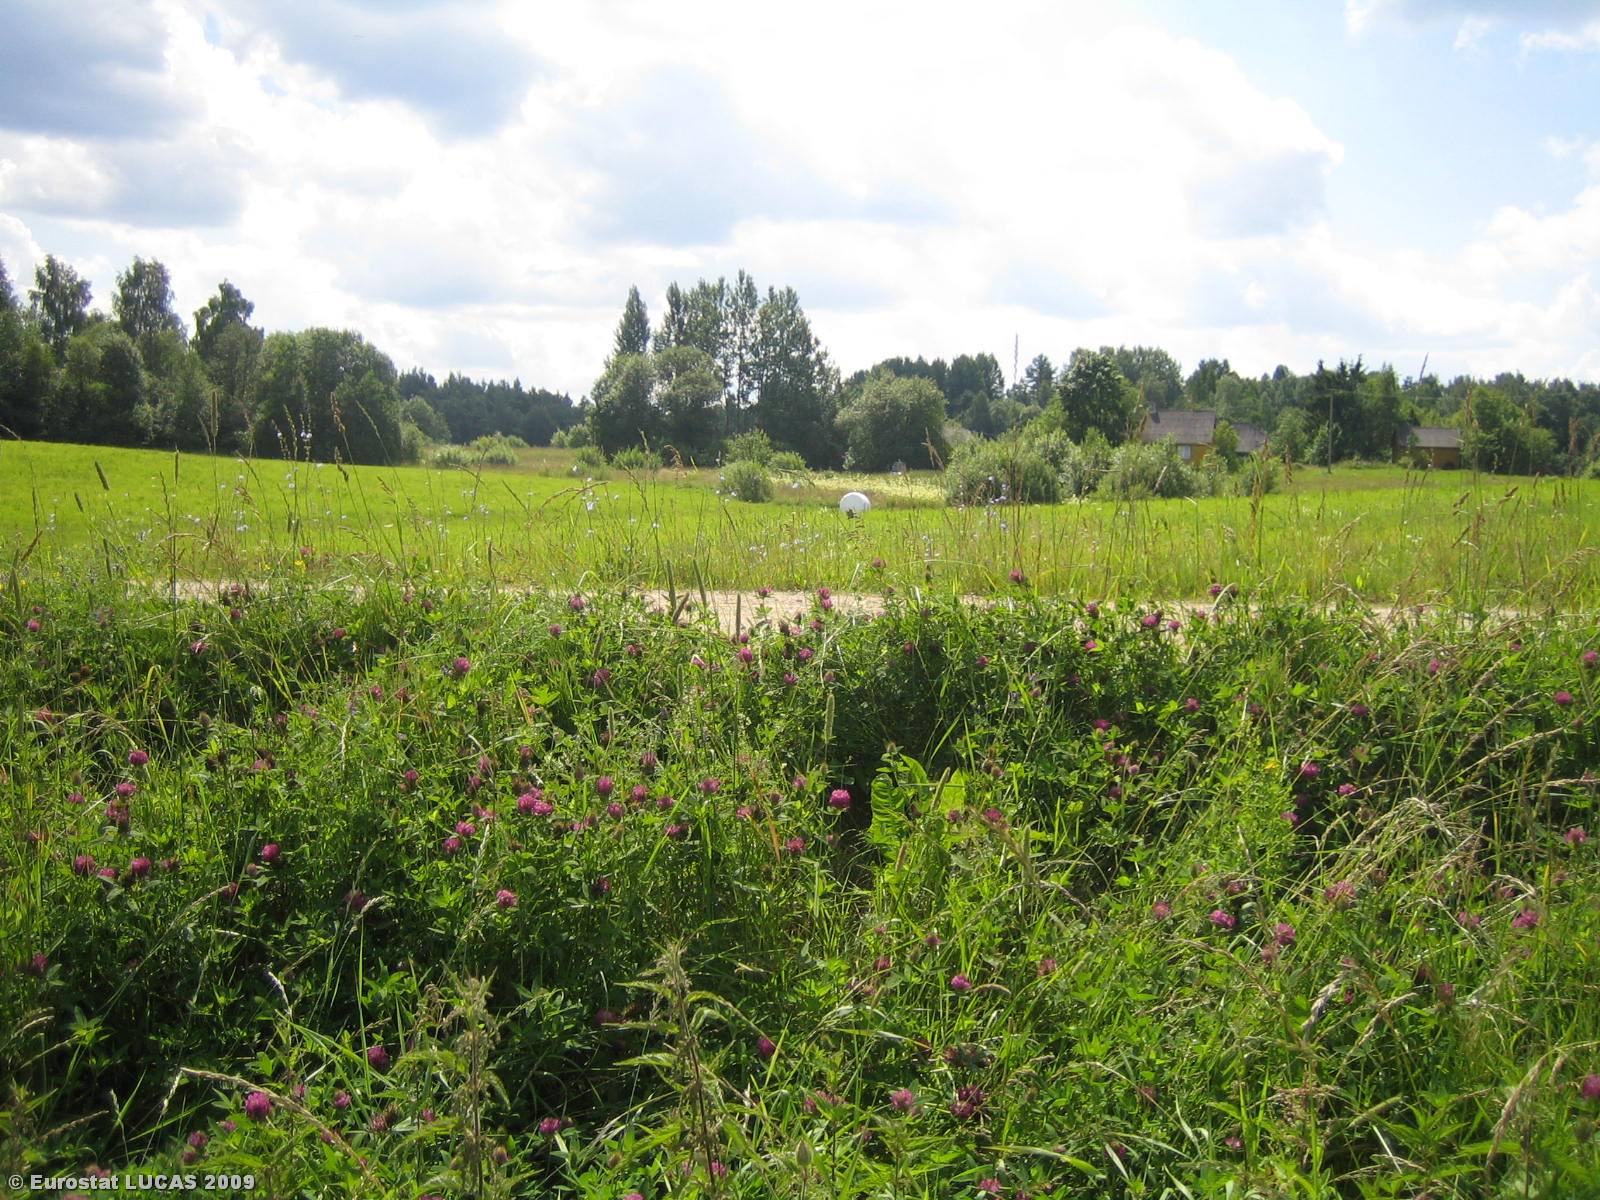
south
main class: Grassland
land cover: Grassland without tree/shrub cover
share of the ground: > 75 %
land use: Agriculture (excluding fallow land and kitchen gardens)
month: July
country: LT
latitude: 55.7706
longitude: 25.9318
